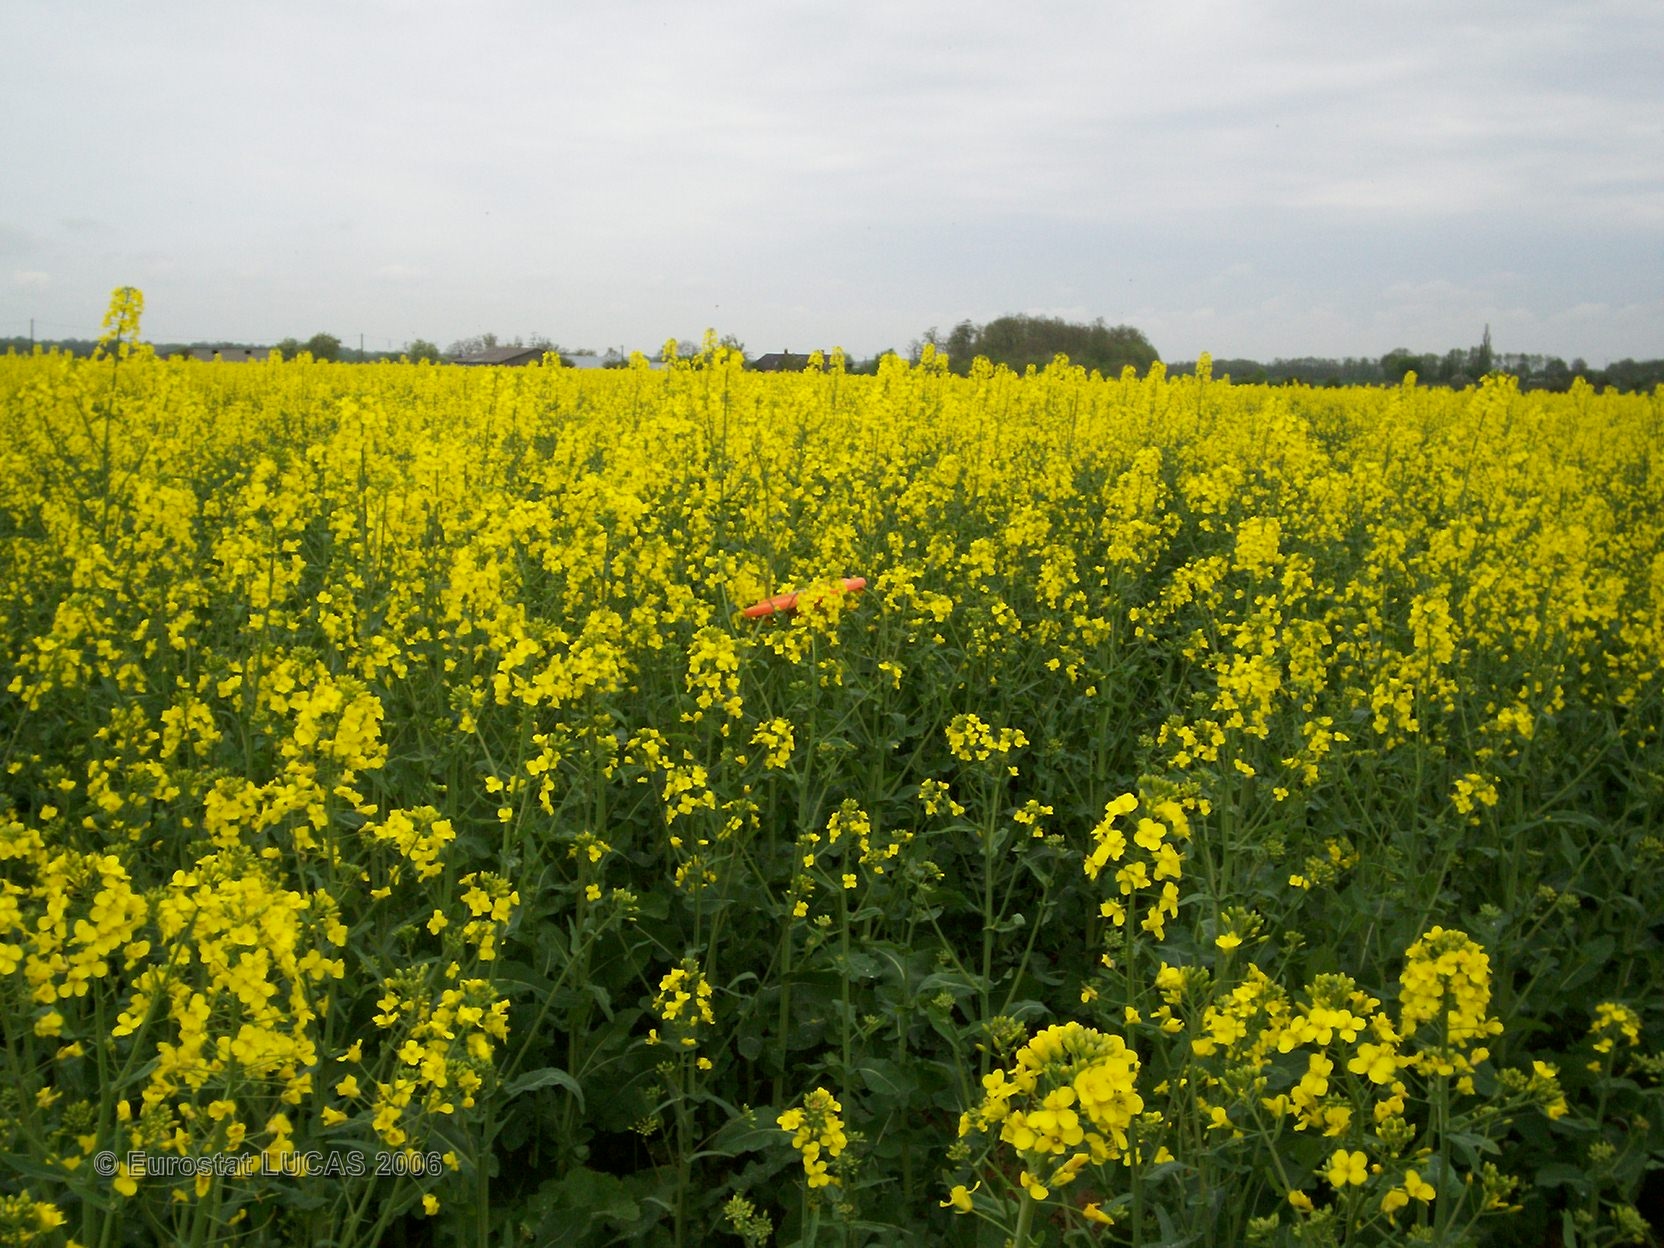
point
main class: Cropland
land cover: Rape and turnip rape
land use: Agriculture (excluding fallow land and kitchen gardens)
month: May
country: FR
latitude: 48.8724
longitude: 0.6088
